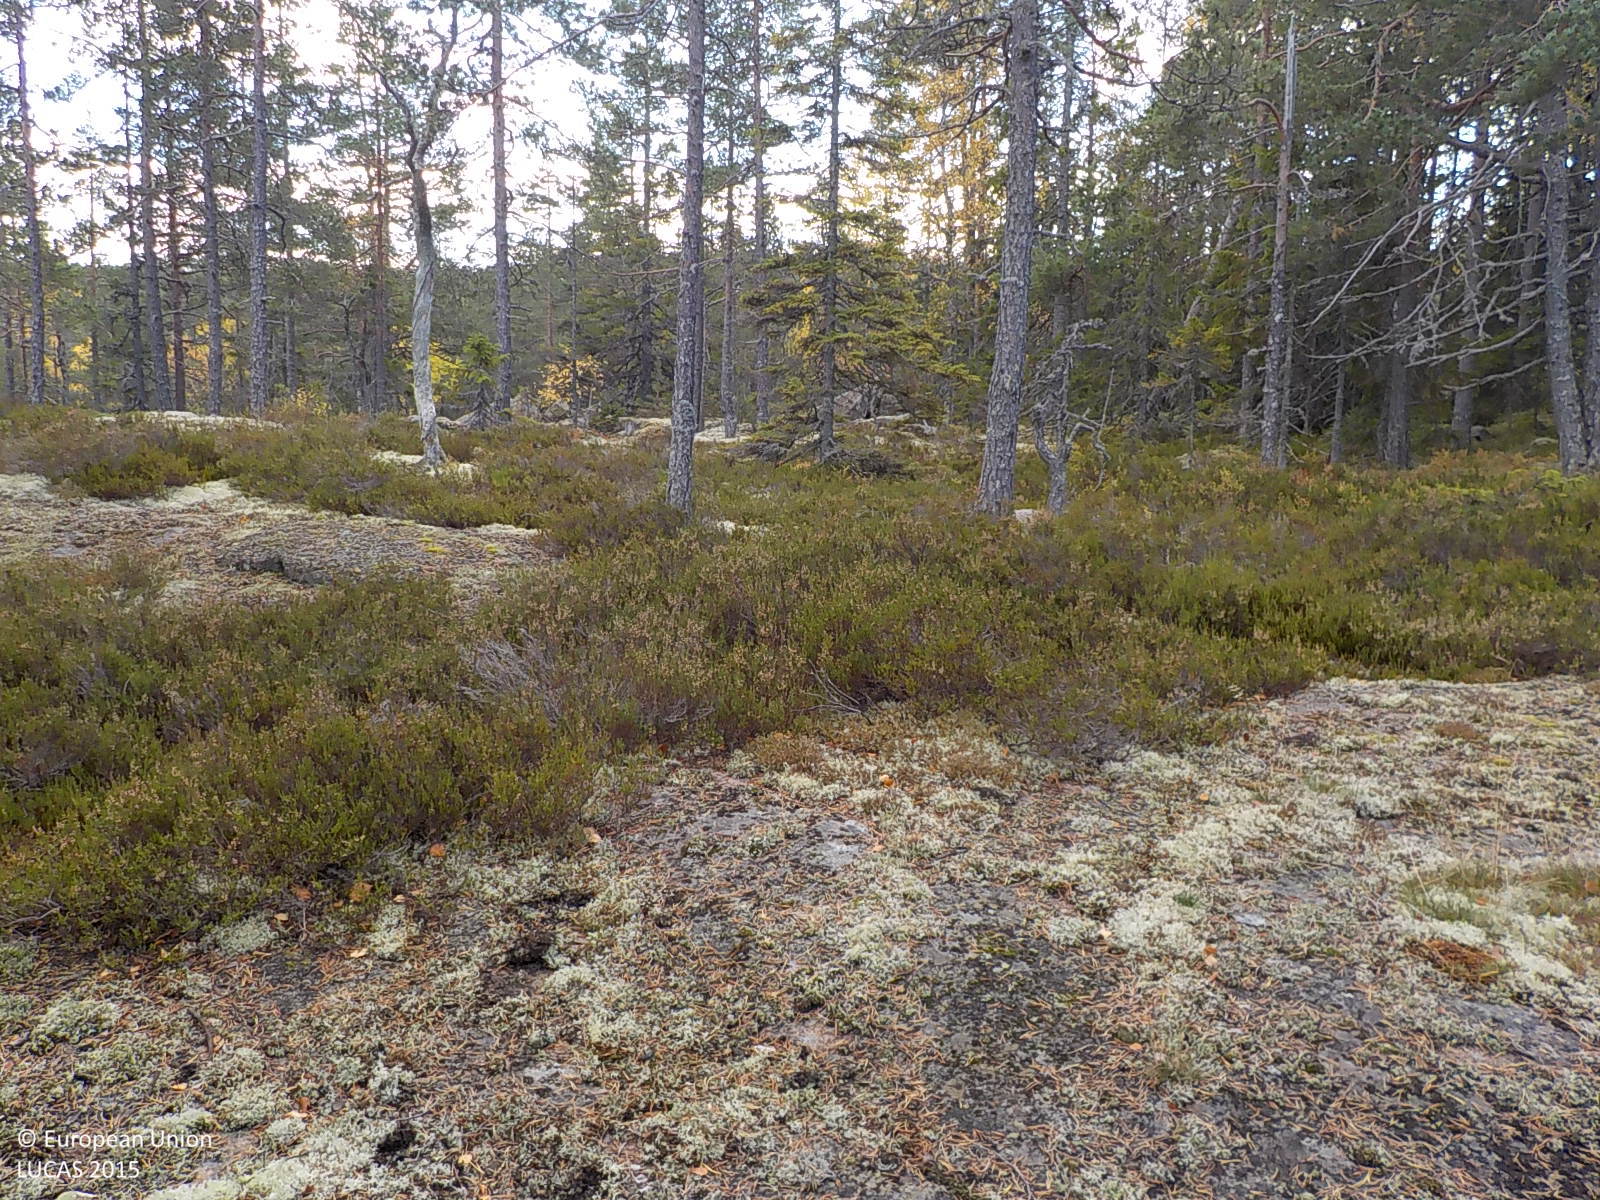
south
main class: Woodland
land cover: Pine dominated coniferous woodland
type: boreal forest
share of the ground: 10 - 25 %
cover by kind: shrubs 50 %, coniferous forest trees 20 %, lichens and mosses 15 %, consolidated bare surface 15 %
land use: Semi-natural and natural areas not in use
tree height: > 5 m
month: October
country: SE
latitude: 62.9921
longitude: 18.4472
